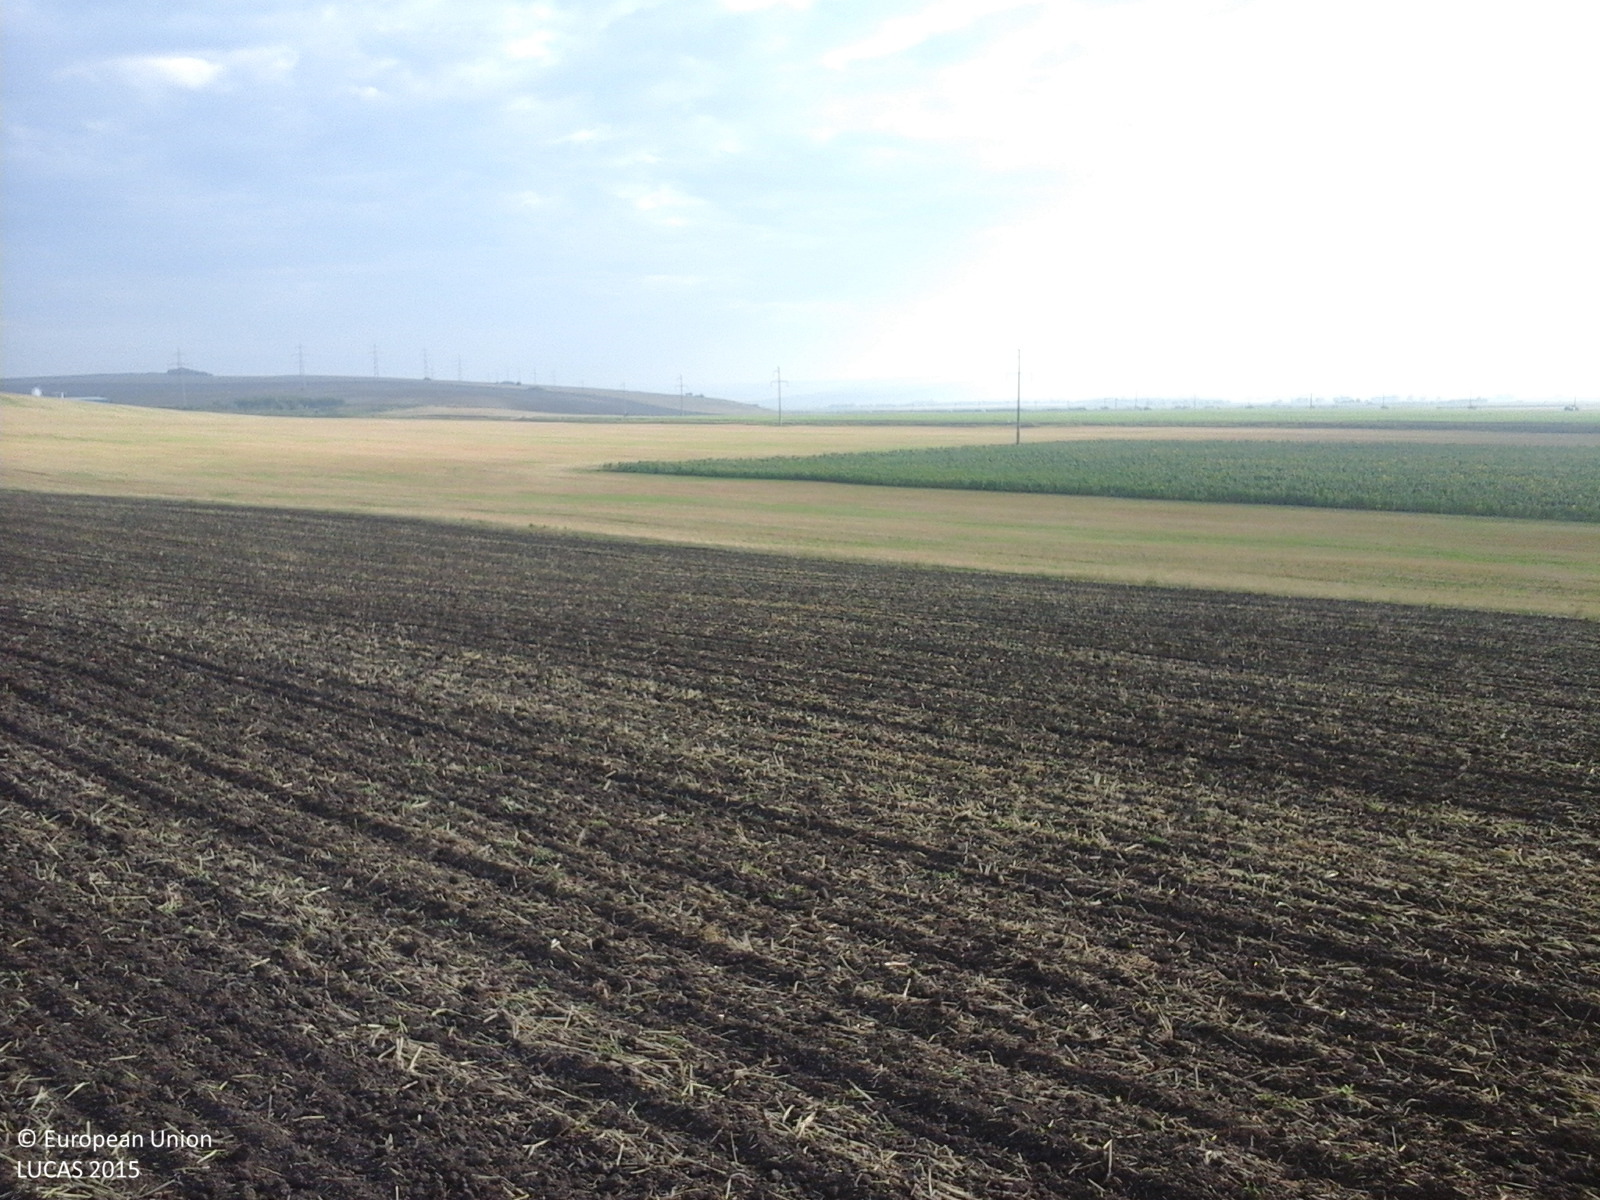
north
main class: Cropland
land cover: Durum wheat
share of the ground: > 75 %
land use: Agriculture (excluding fallow land and kitchen gardens)
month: July
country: RO
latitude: 46.4092
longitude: 27.7980
